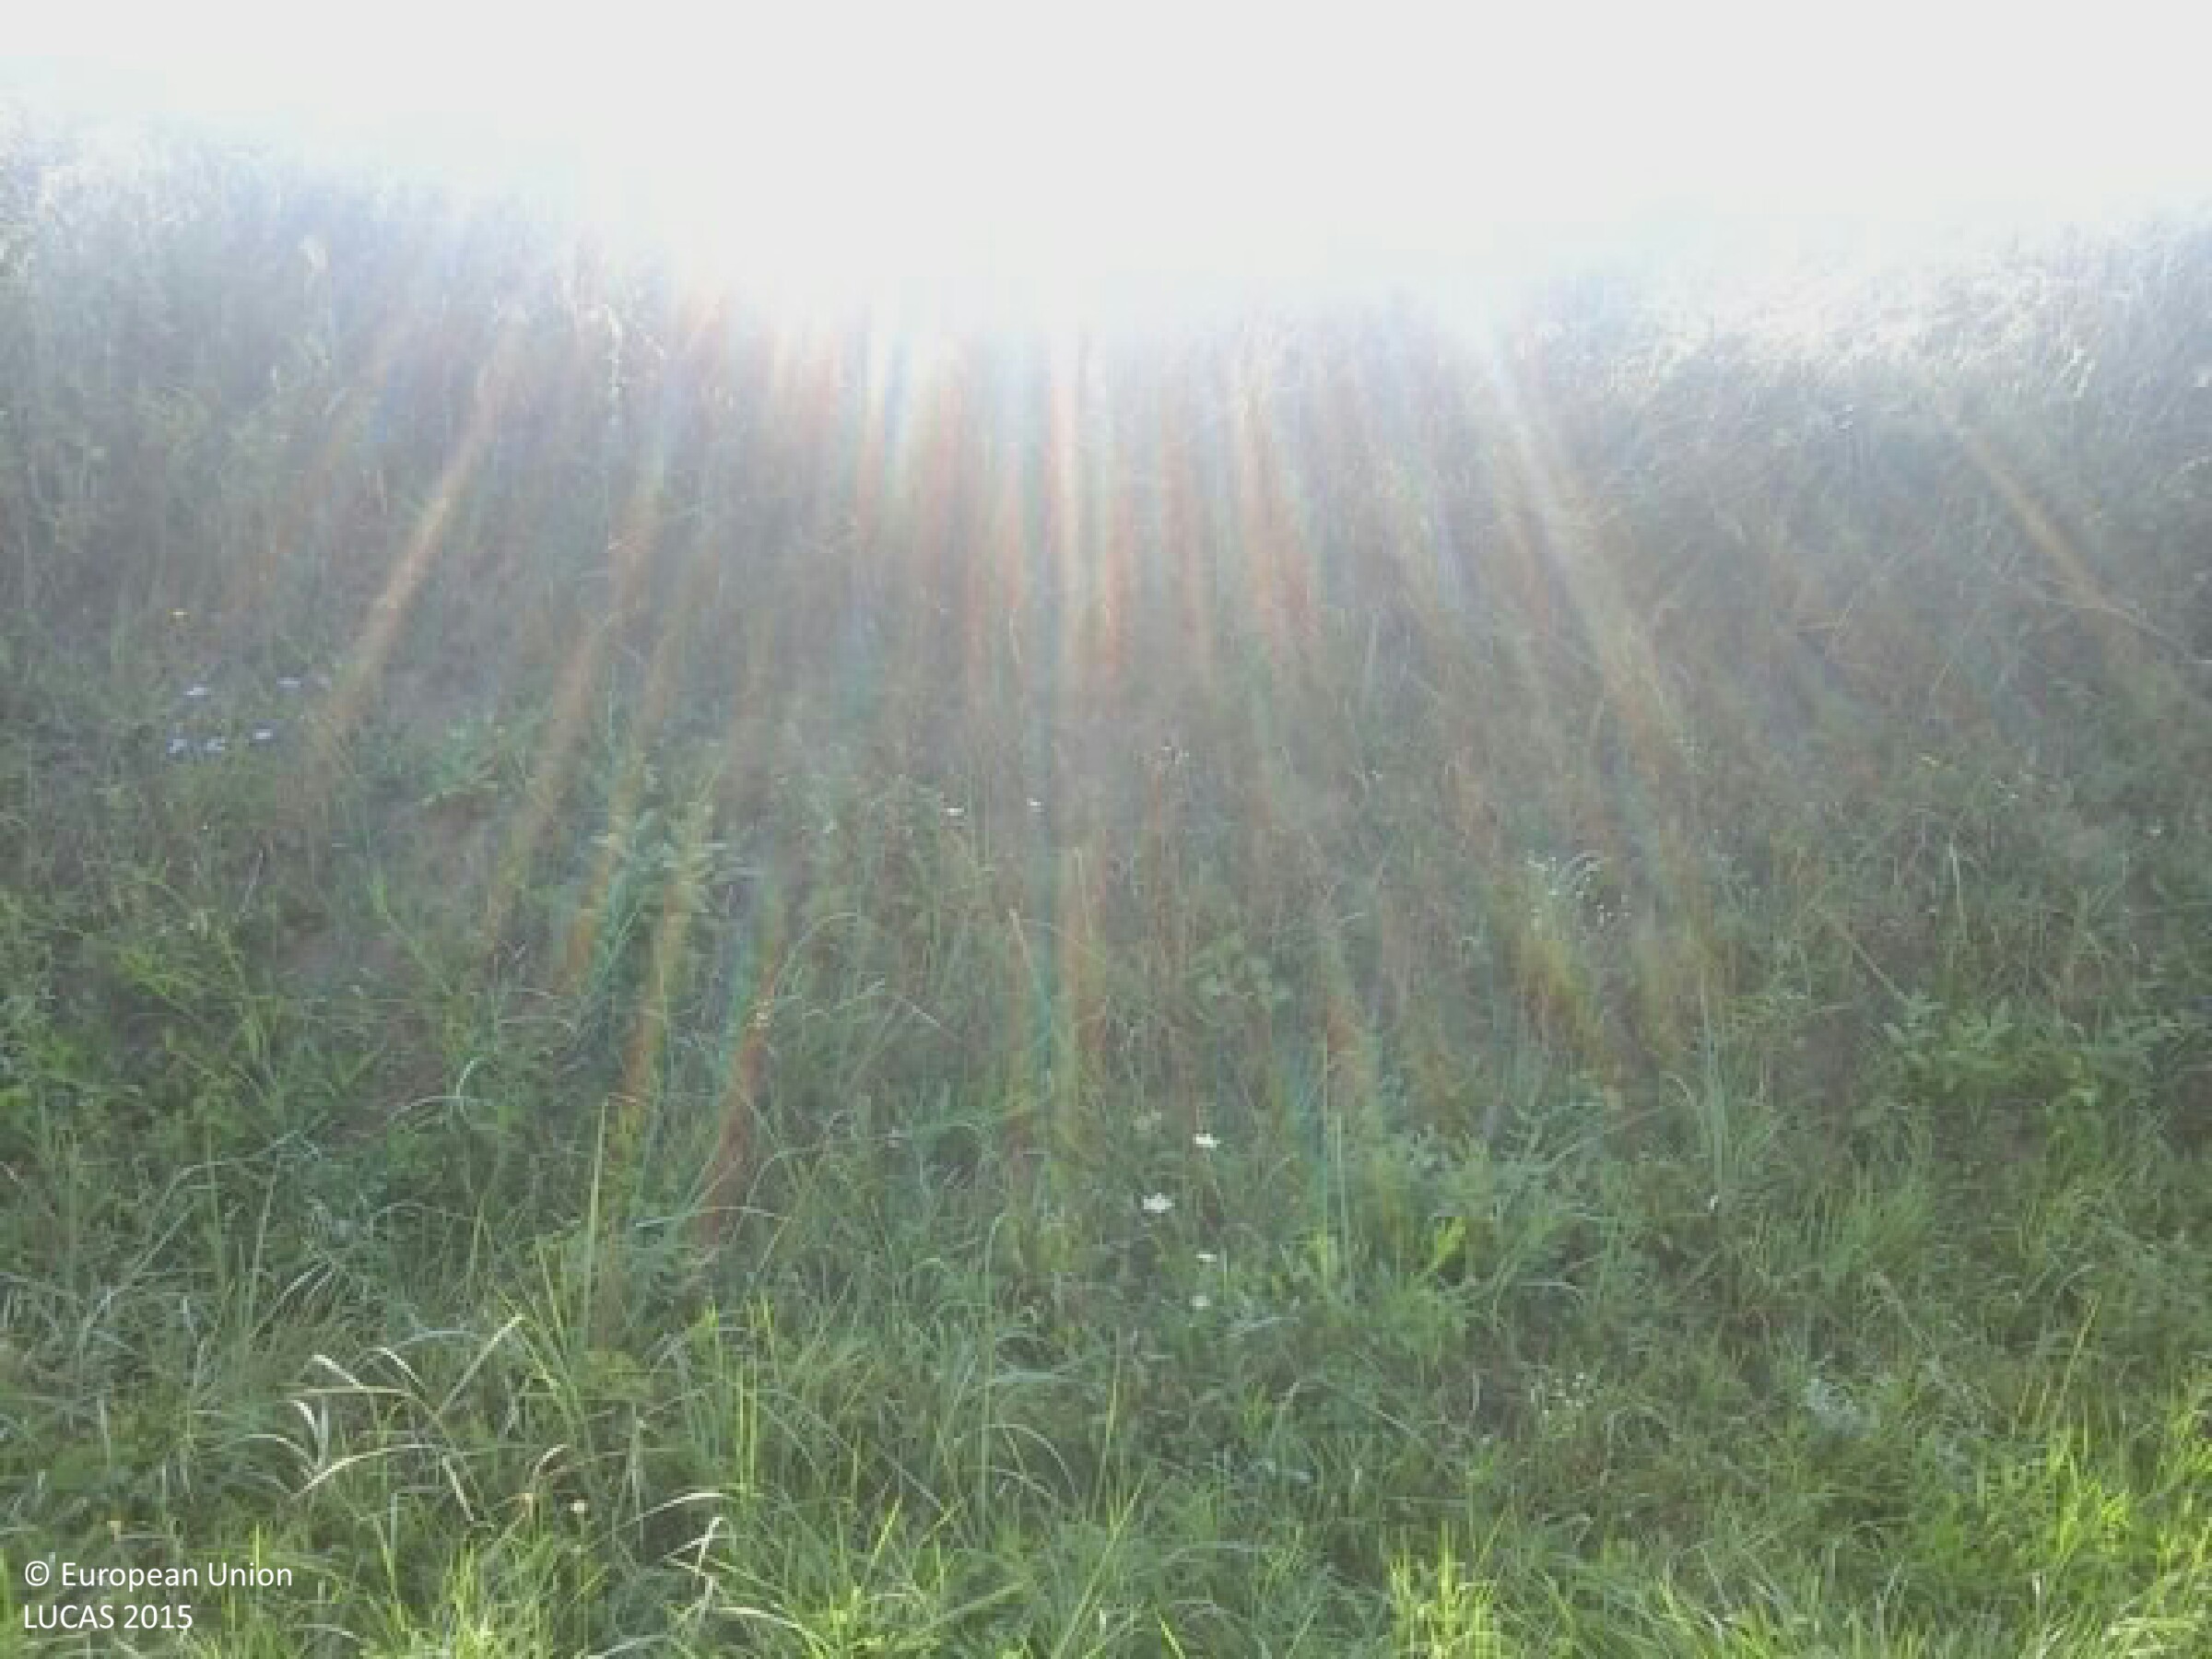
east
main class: Grassland
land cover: Grassland without tree/shrub cover
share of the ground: > 75 %
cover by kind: herbaceous plants 100 %
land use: Protection infrastructures
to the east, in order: Grassland without tree/shrub cover; Ditches and canals; Artificial constructions in urban areas; Grassland without tree/shrub cover; Maize
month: August
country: HU
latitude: 46.3650
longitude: 18.1576
